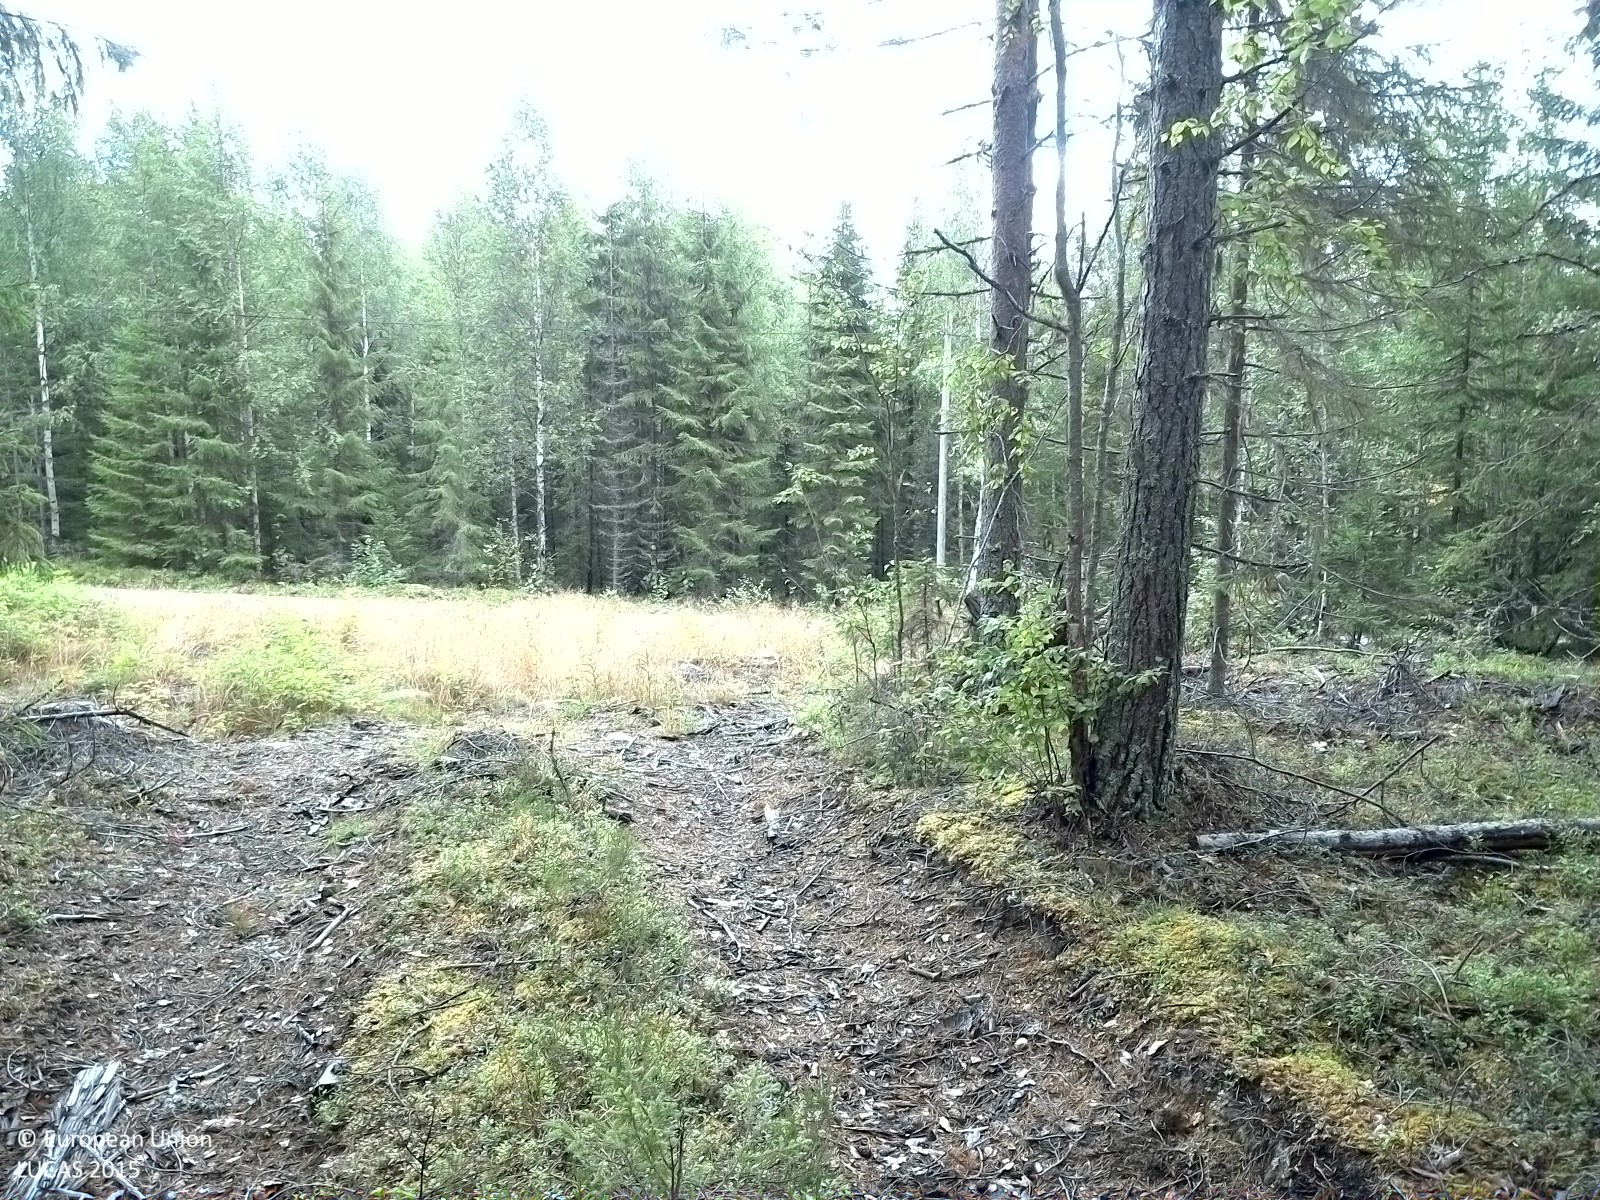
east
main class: Woodland
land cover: Pine dominated coniferous woodland
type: boreal forest
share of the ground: 50 - 75 %
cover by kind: coniferous forest trees 60 %, shrubs 20 %, lichens and mosses 20 %
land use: Forestry
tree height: > 5 m
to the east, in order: Pine dominated coniferous woodland; Ditches and canals; Paved roads, cycling and walking lanes; Ditches and canals; Spruce dominated mixed woodland
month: August
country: SE
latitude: 62.6882
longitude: 16.5227
